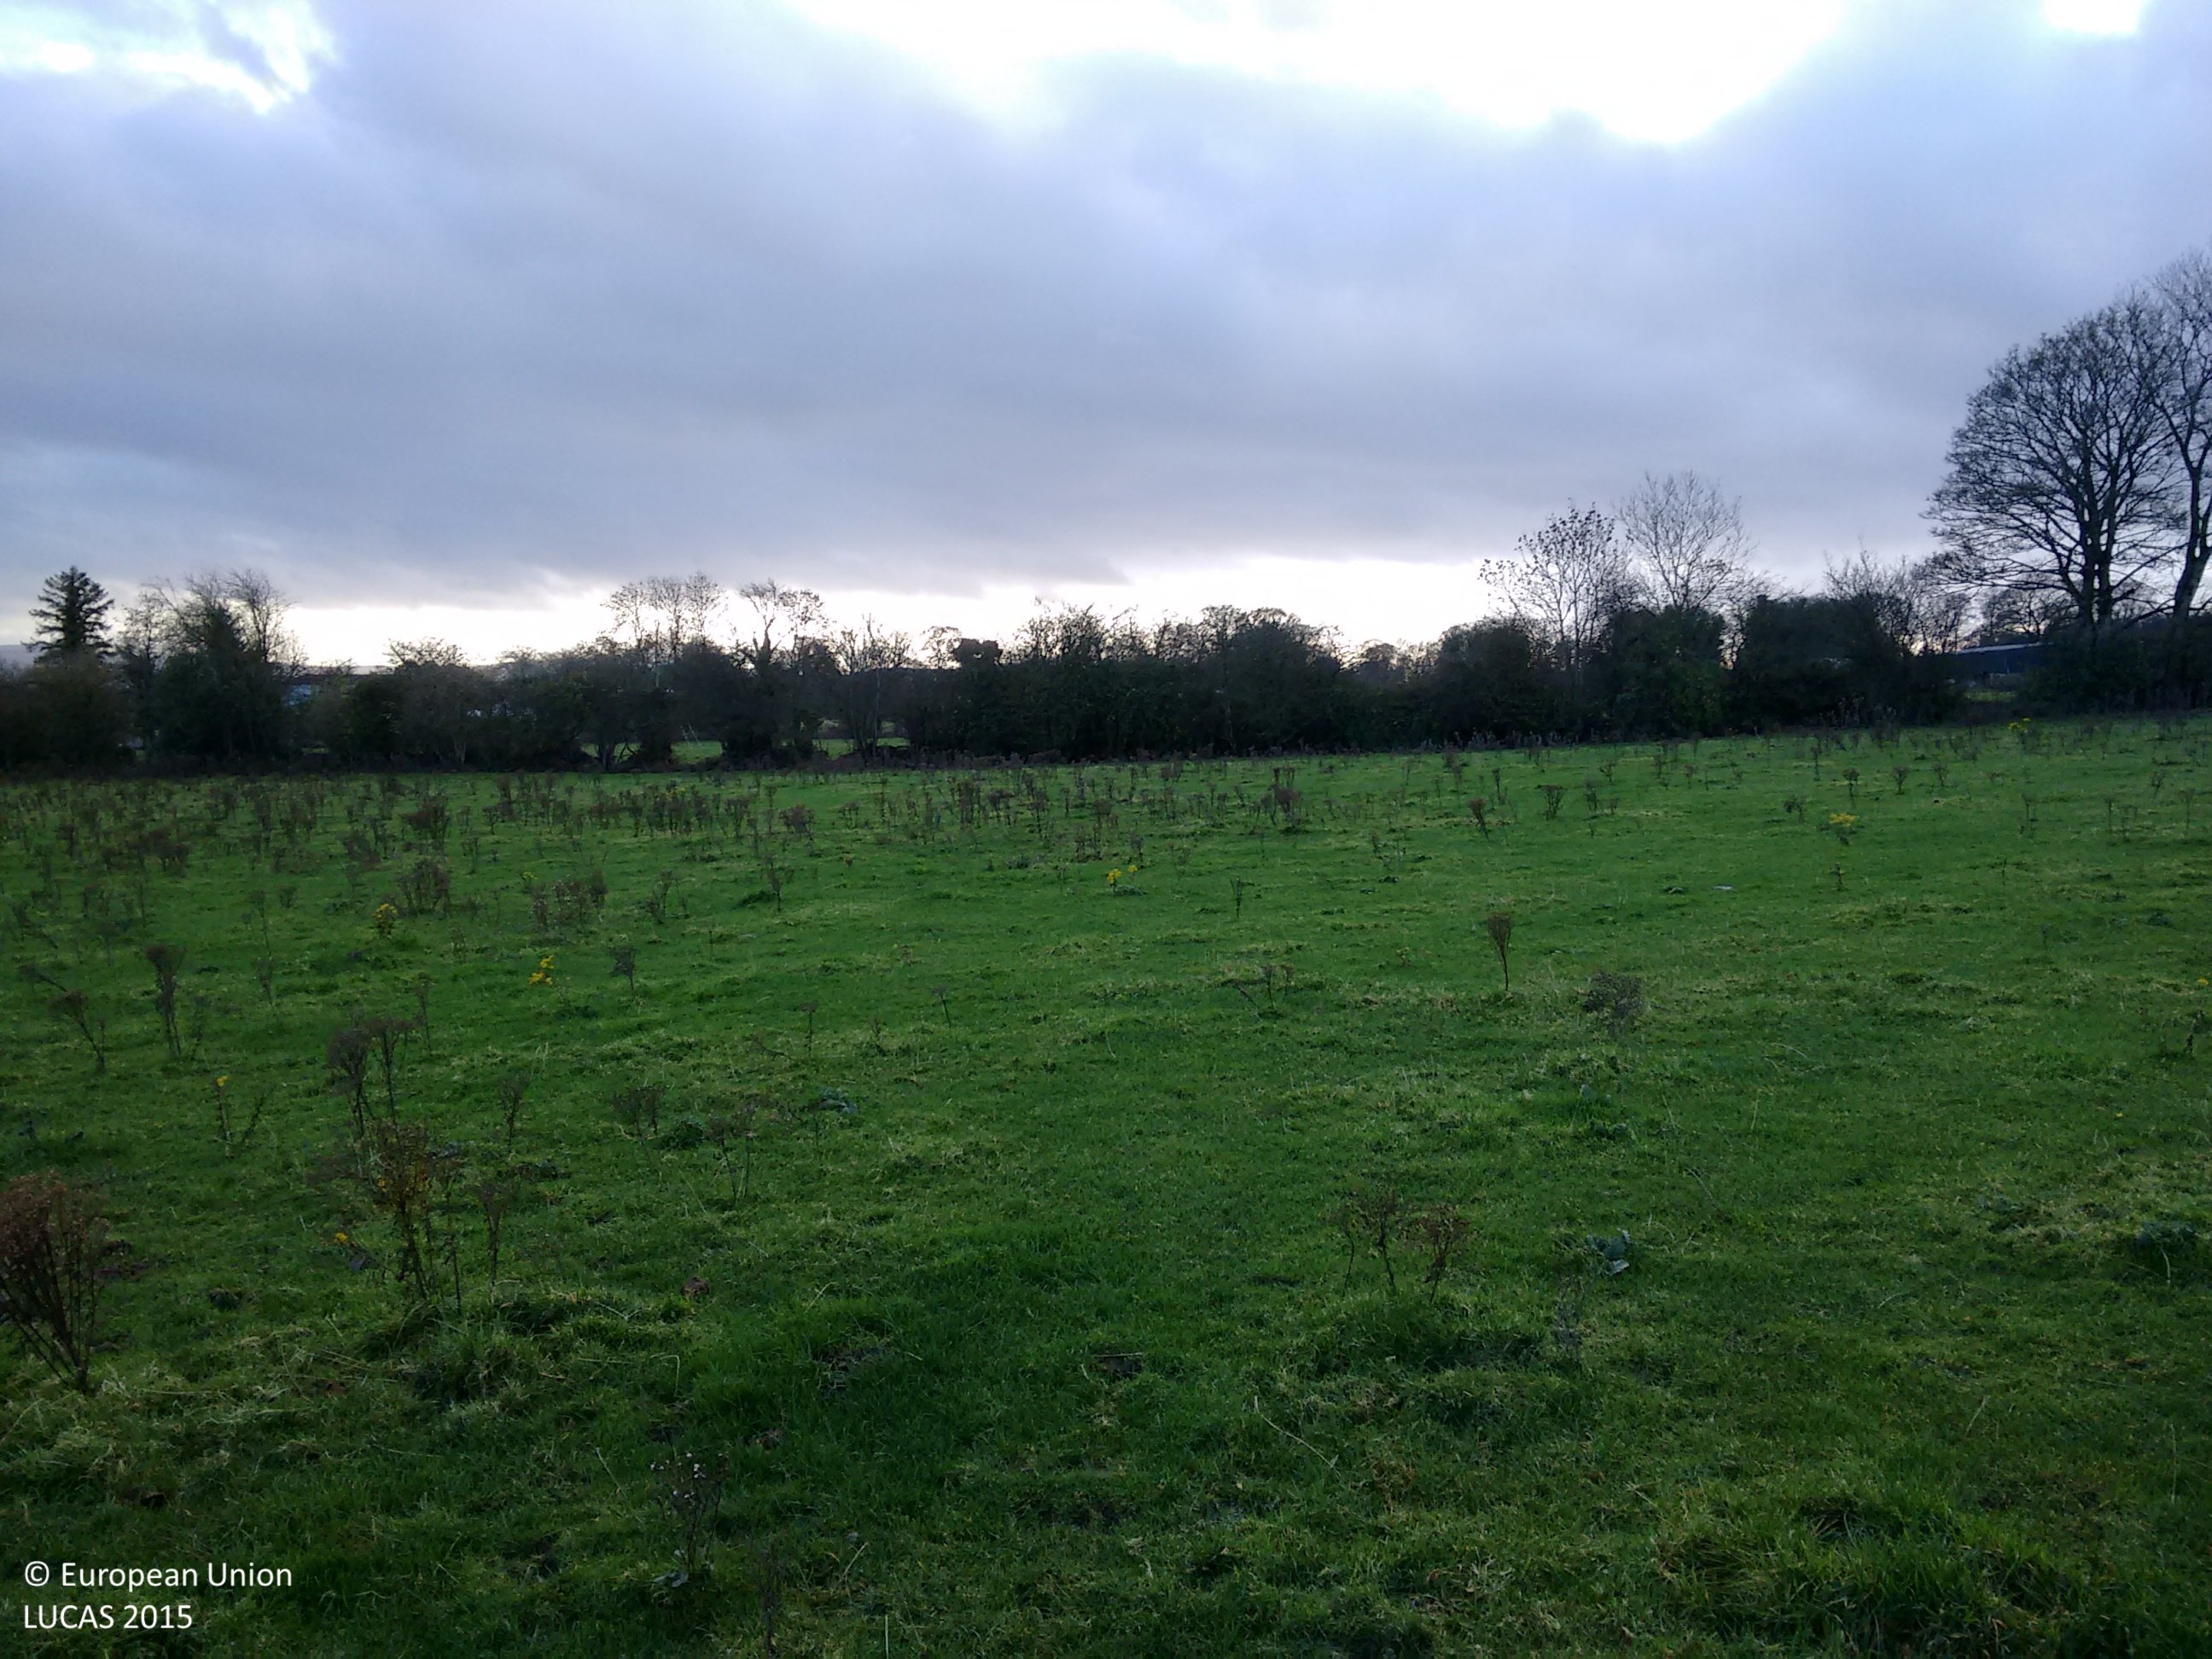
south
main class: Grassland
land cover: Grassland without tree/shrub cover
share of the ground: > 75 %
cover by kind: herbaceous plants 100 %
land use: Agriculture (excluding fallow land and kitchen gardens)
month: November
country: IE
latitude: 53.1504
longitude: -6.5619
